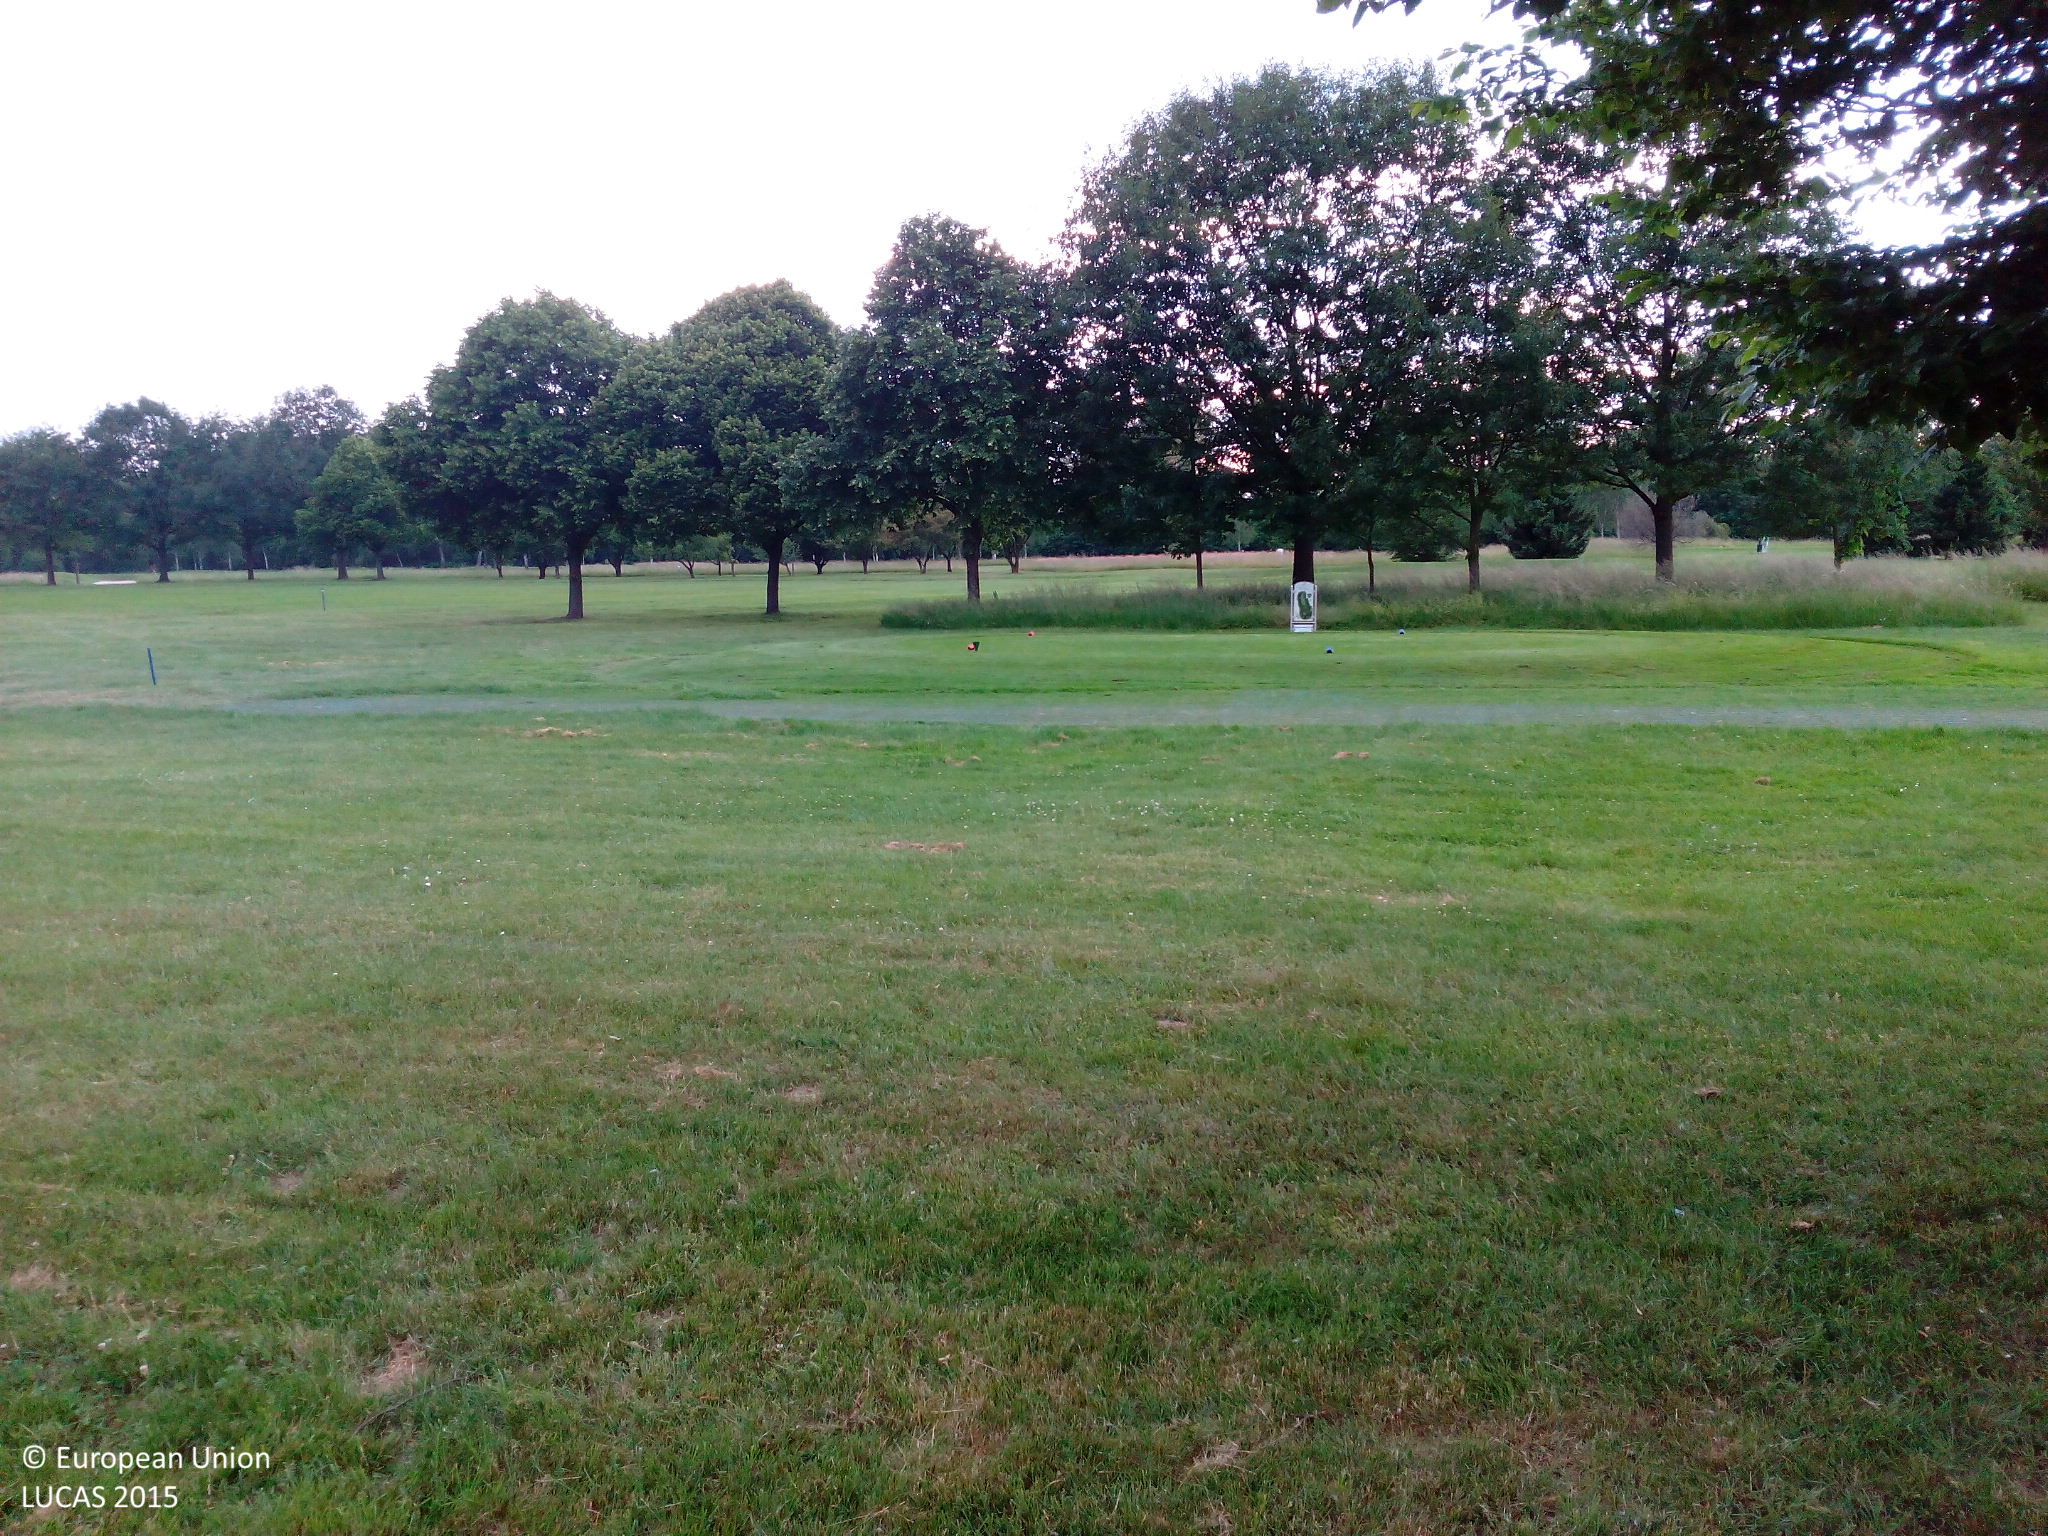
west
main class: Grassland
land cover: Grassland without tree/shrub cover
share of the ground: > 75 %
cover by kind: herbaceous plants 95 %, consolidated bare surface 5 %
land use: Air transport
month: May
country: DE
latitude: 48.7828
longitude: 8.0817
